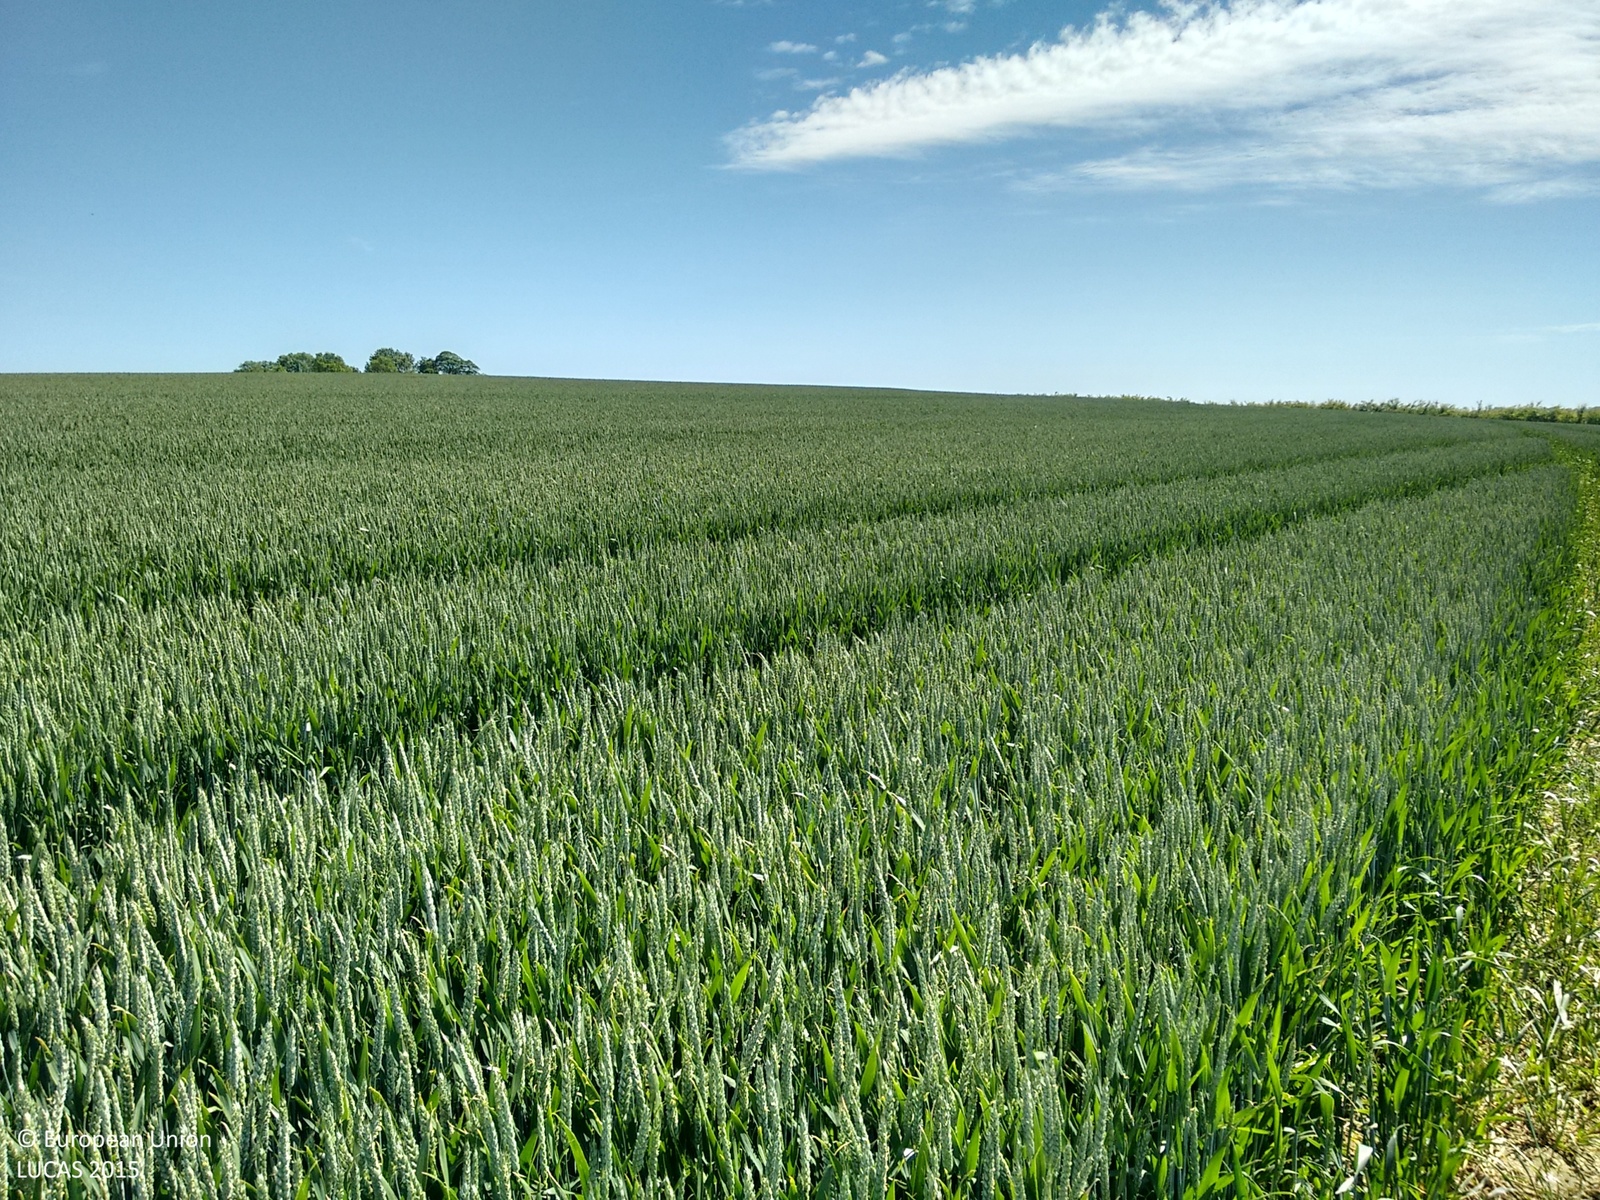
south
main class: Cropland
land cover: Common wheat
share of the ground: > 75 %
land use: Agriculture (excluding fallow land and kitchen gardens)
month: June
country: GB
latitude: 51.0381
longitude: 0.7473
